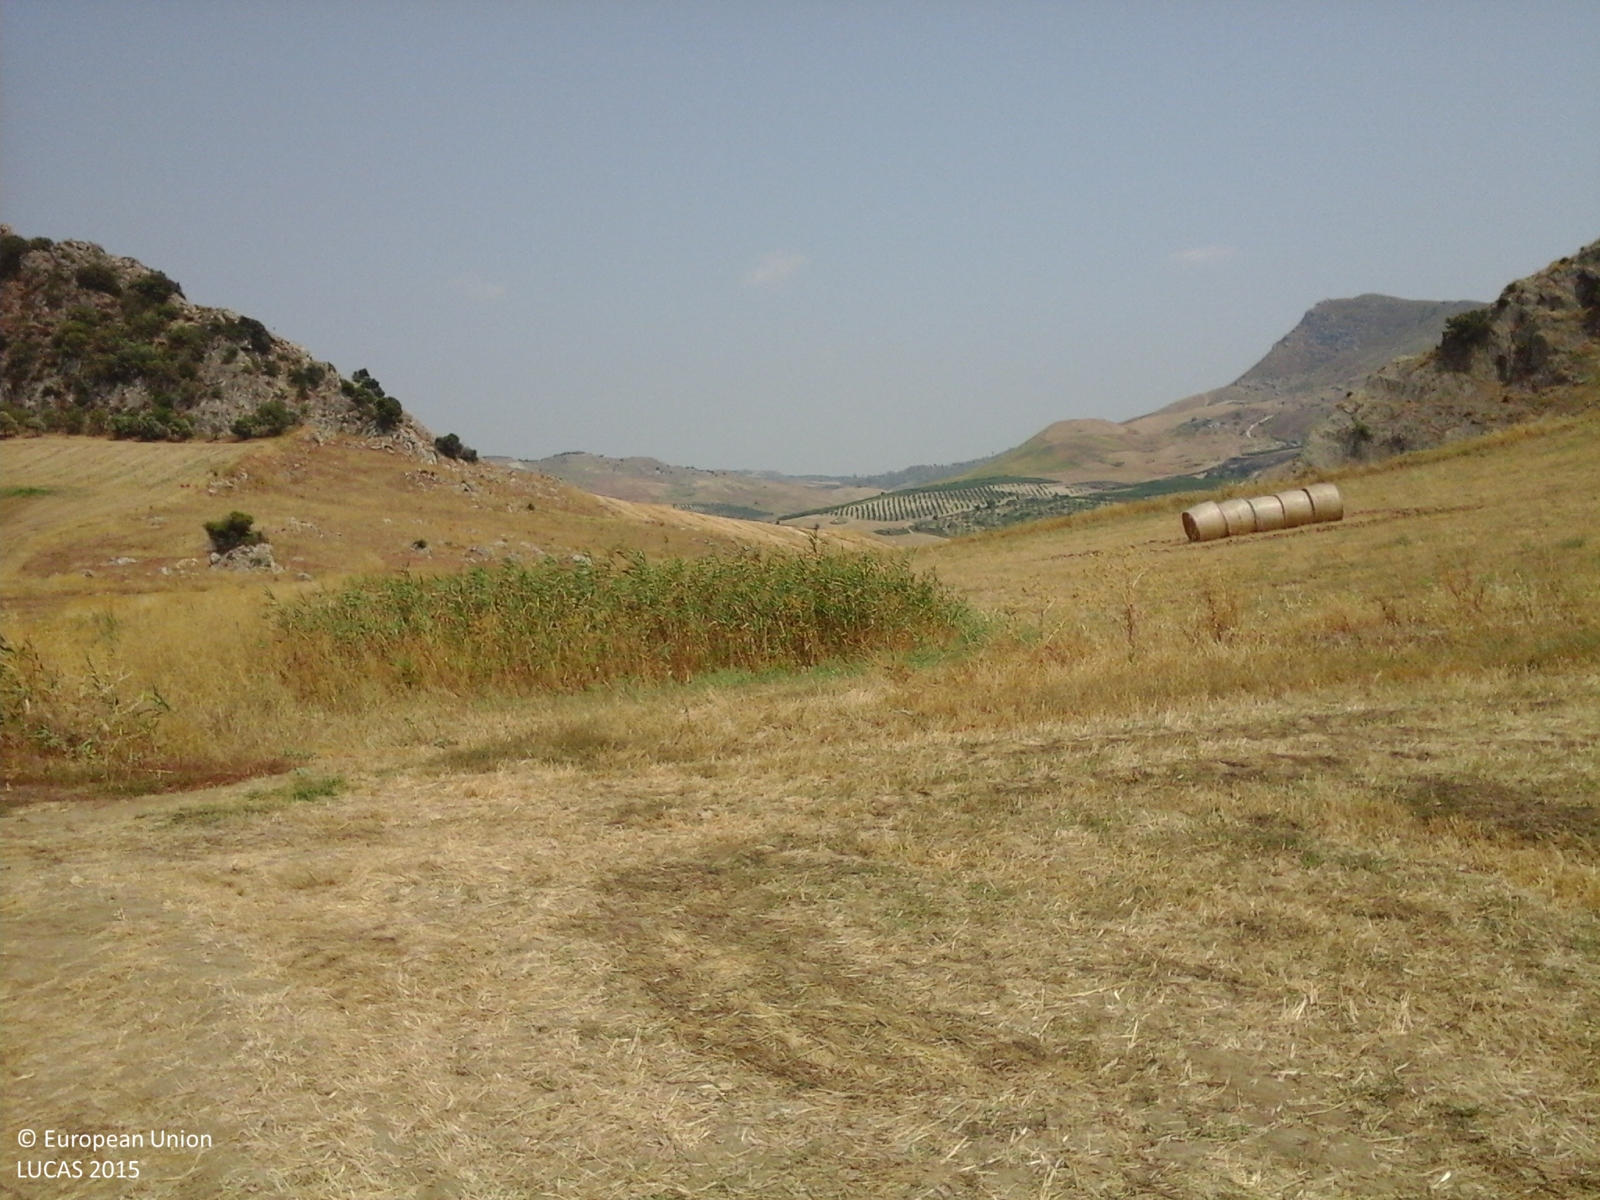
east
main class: Grassland
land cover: Grassland without tree/shrub cover
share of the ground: > 75 %
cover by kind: herbaceous plants 100 %
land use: Agriculture (excluding fallow land and kitchen gardens)
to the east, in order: Grassland without tree/shrub cover
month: July
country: IT
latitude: 37.2809
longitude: 14.0180
